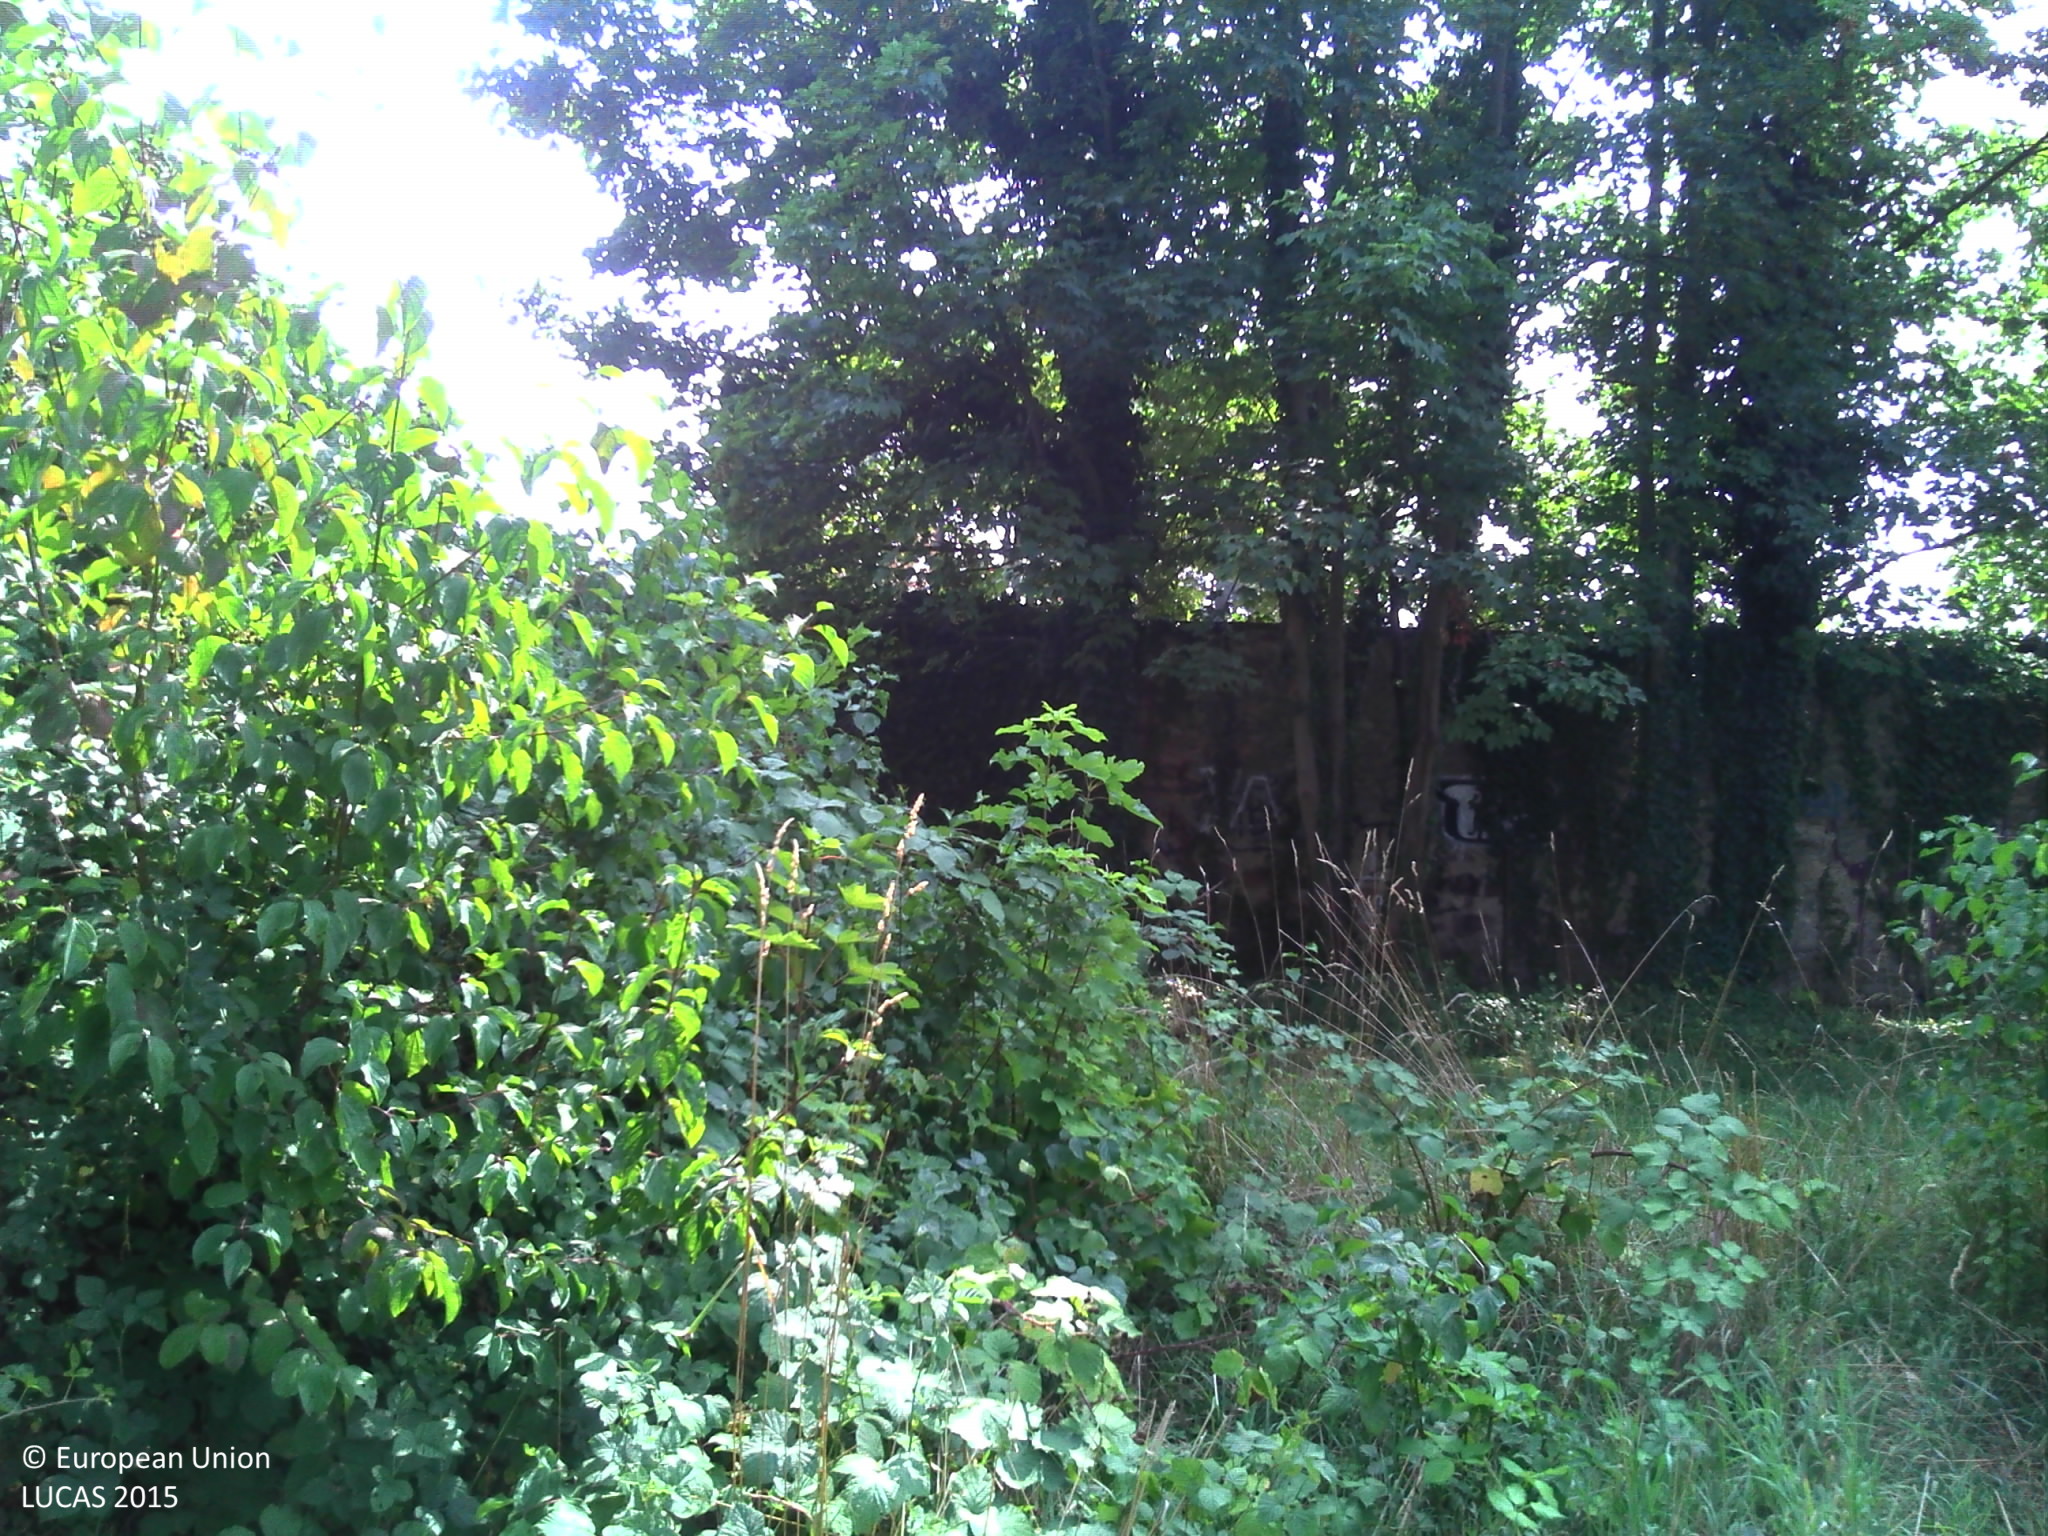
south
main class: Grassland
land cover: Spontaneously vegetated surfaces
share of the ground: > 75 %
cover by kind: herbaceous plants 100 %
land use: Semi-natural and natural areas not in use
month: August
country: FR
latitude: 48.6154
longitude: 7.7898
